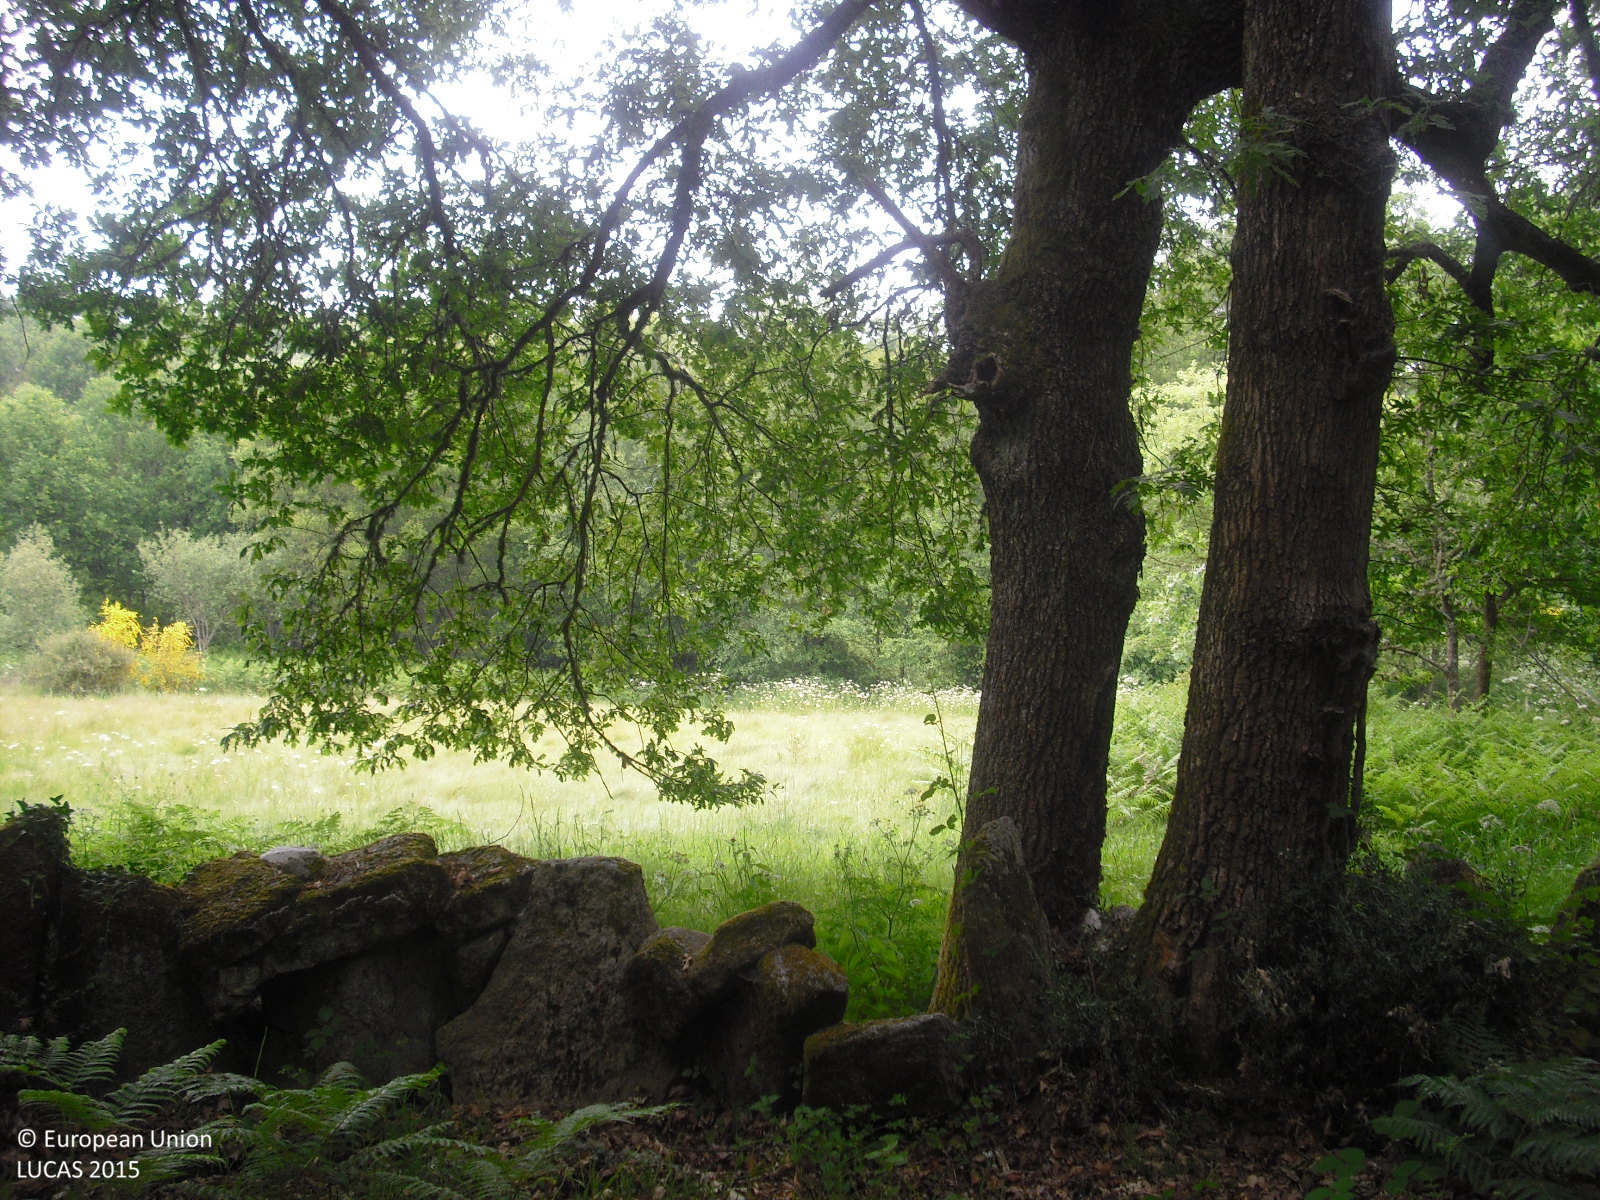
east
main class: Woodland
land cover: Broadleaved woodland
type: acidophilous oak and oak-birch forest
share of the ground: > 75 %
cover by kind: broadleaved forest trees 100 %
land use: Forestry
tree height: > 5 m
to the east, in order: Broadleaved woodland; Dry stone walls; Grassland without tree/shrub cover; Electric lines; Grassland without tree/shrub cover; Groves; Rivers and streams; Dry stone walls; Groves; Grassland without tree/shrub cover; Broadleaved woodland; Dry stone walls; Tracks; Shrubland without tree cover; Shrubland with sparse tree cover; Rock outcrops; Shrubland with sparse tree cover; Dry stone walls; Shrubland with sparse tree cover; Shrubland without tree cover; Shrubland with sparse tree cover; Dry stone walls; Broadleaved woodland; Shrubland without tree cover; Broadleaved woodland; Ditches and canals; Broadleaved woodland; Dry stone walls; Broadleaved woodland
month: May
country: ES
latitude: 42.1988
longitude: -7.8407
